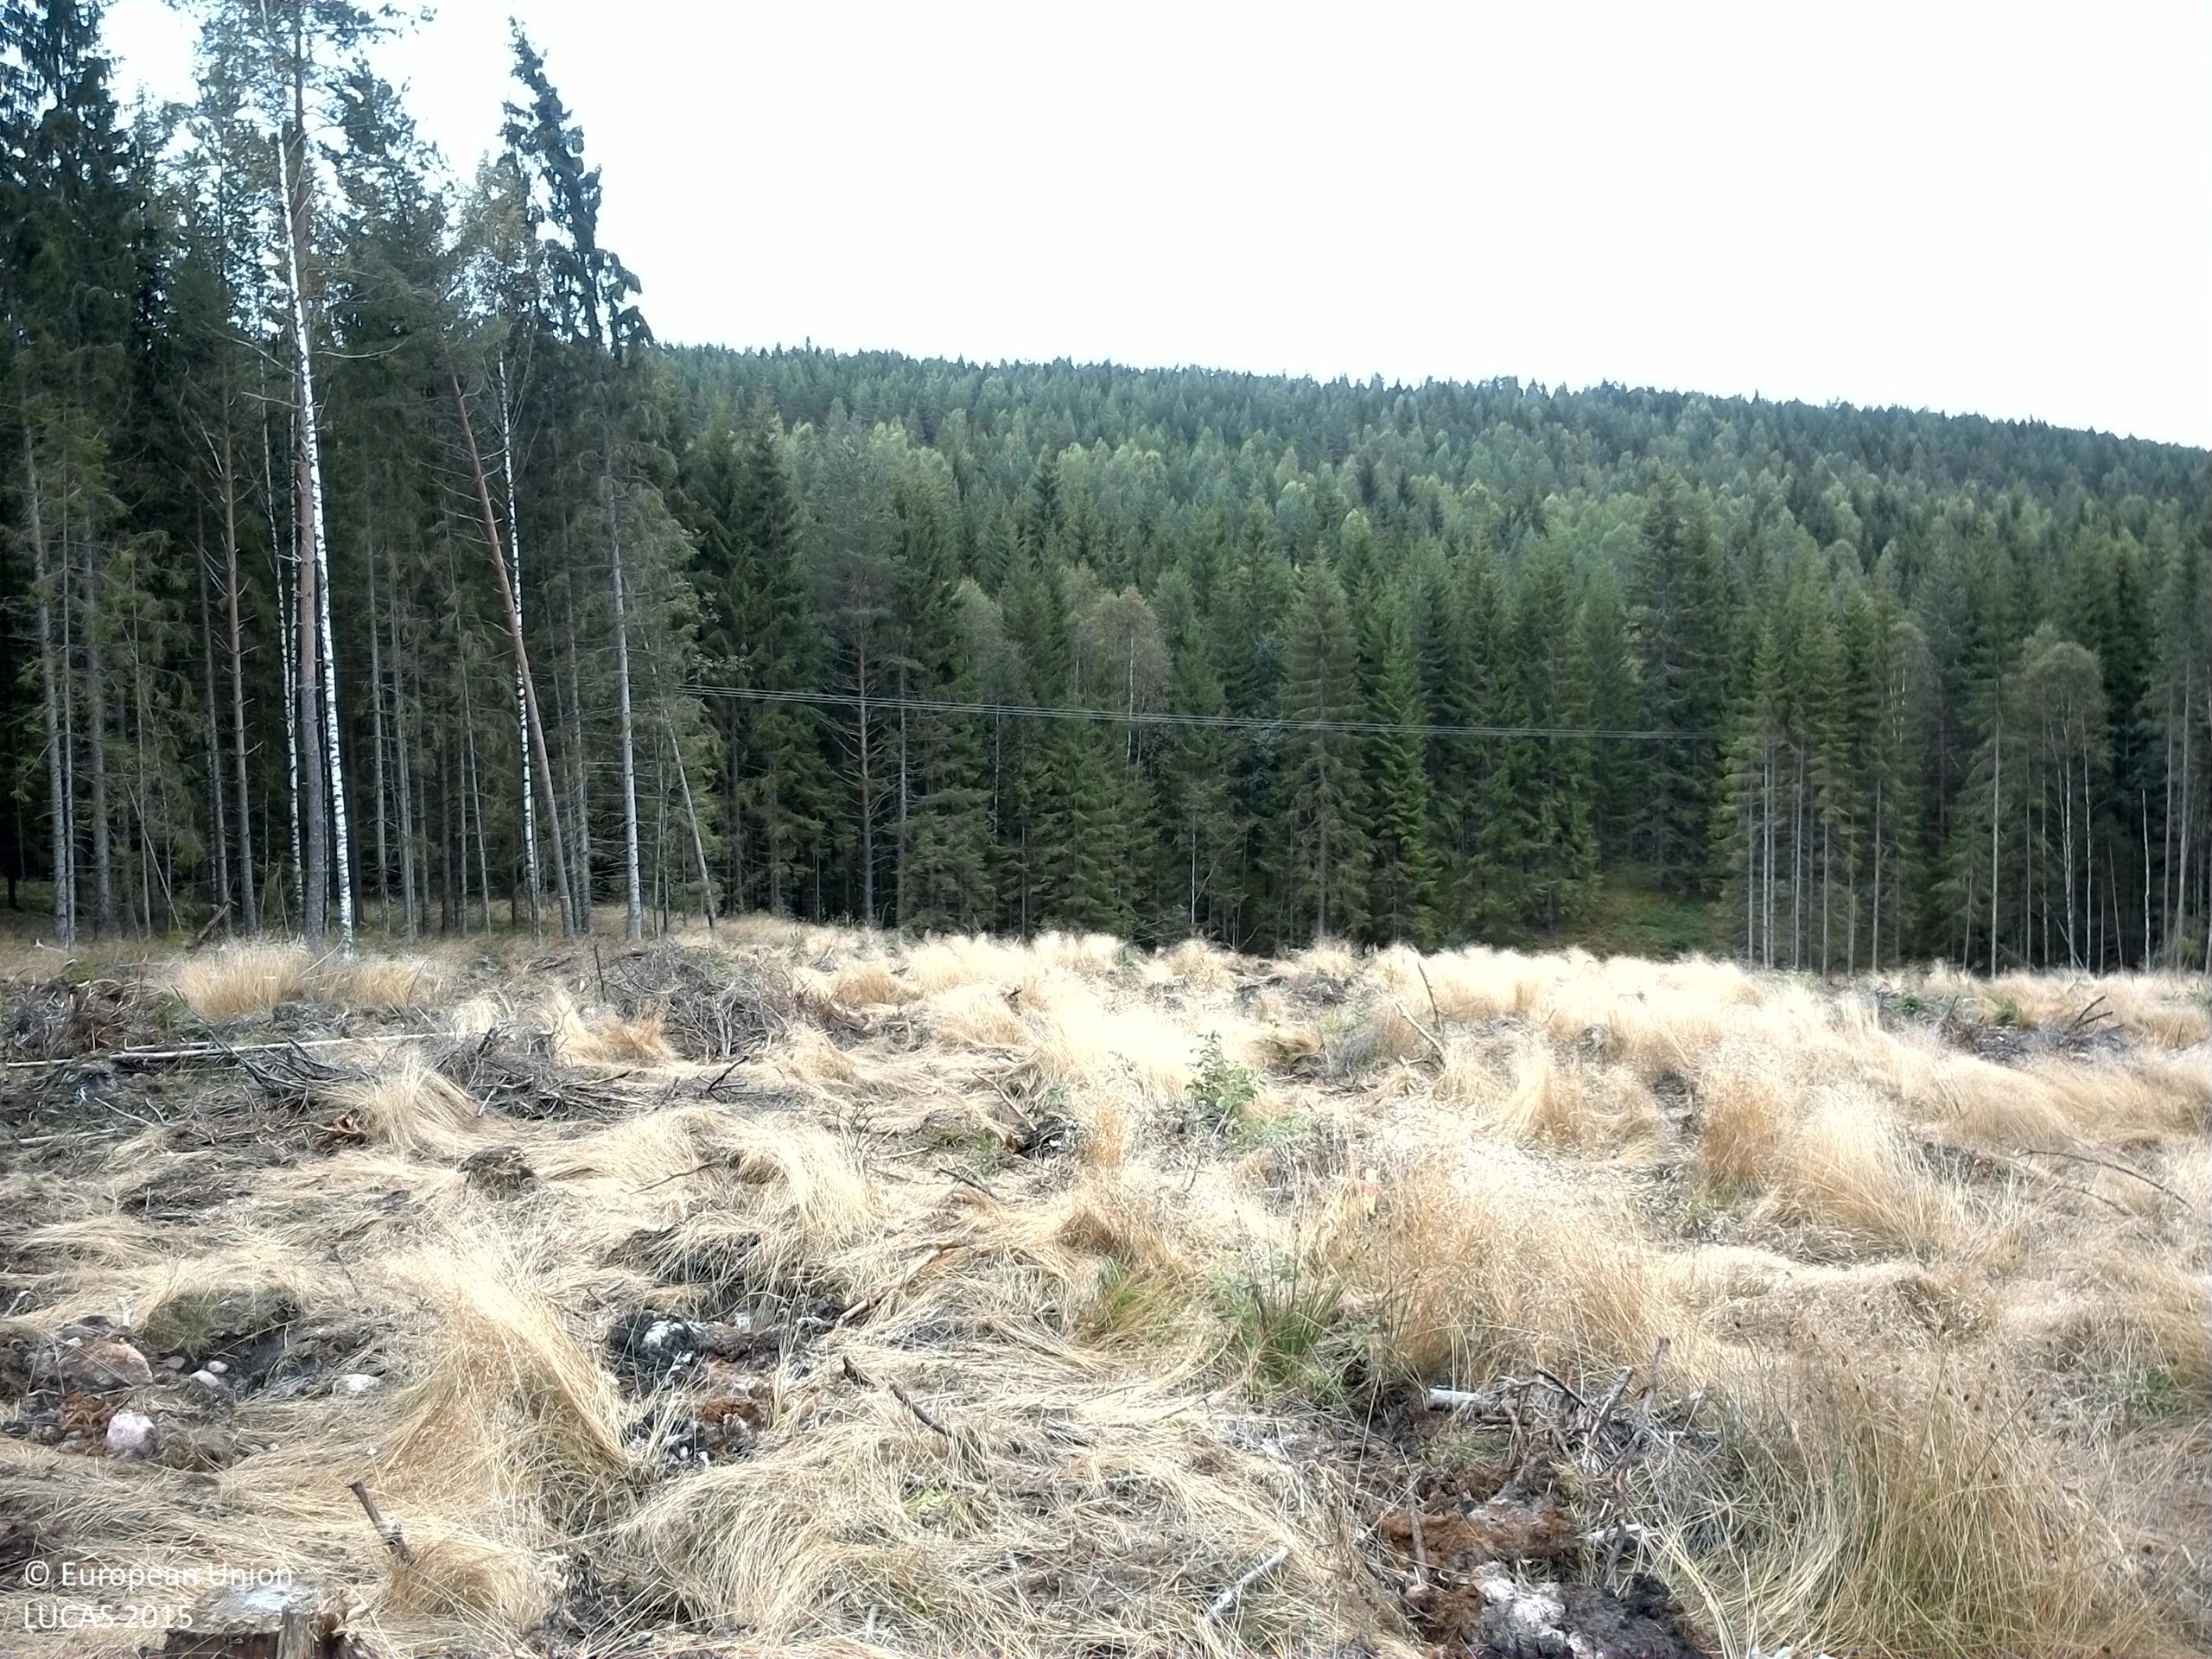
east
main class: Grassland
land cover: Grassland with sparse tree/shrub cover
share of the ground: 50 - 75 %
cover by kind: herbaceous plants 55 %, consolidated bare surface 25 %, broadleaved forest trees 5 %, shrubs 5 %
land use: Forestry
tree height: > 5 m
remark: Clear cut
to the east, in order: Grassland with sparse tree/shrub cover; Electric lines; Spruce dominated coniferous woodland; Rivers and streams; Spruce dominated coniferous woodland; Pine dominated coniferous woodland; Rocks and stones; Pine dominated coniferous woodland
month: September
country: SE
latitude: 59.7615
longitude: 13.3917
